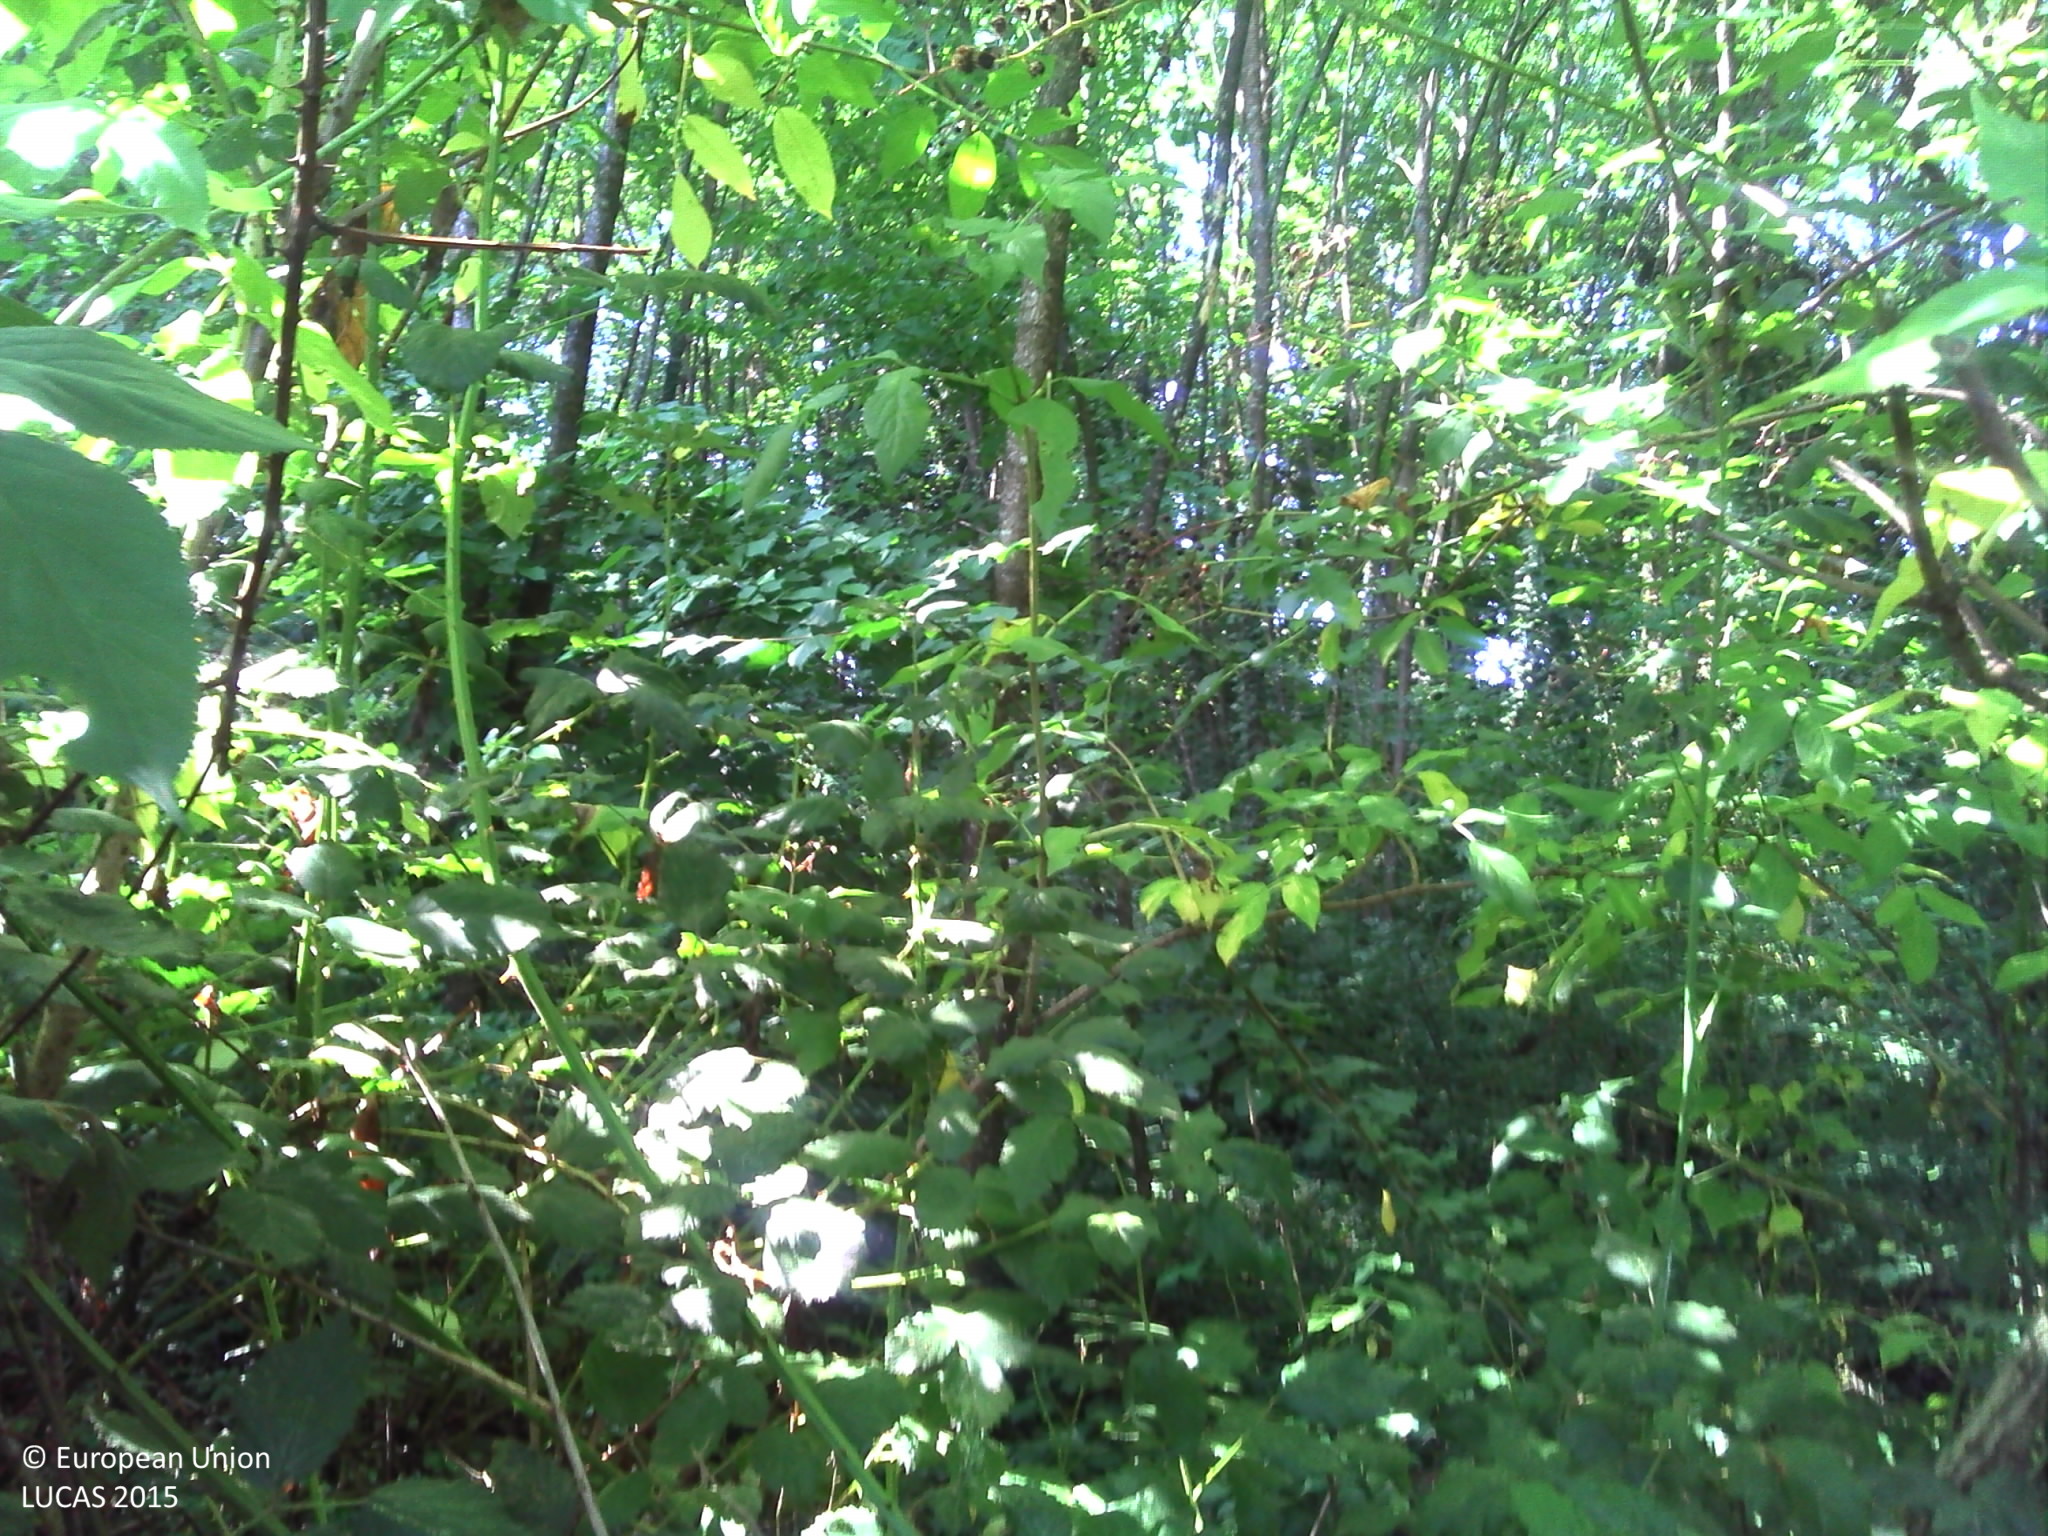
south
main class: Woodland
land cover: Broadleaved woodland
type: thermophilous deciduous forest
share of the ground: > 75 %
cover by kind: broadleaved forest trees 65 %, shrubs 20 %, herbaceous plants 10 %, lichens and mosses 5 %
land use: Forestry
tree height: > 5 m
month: August
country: FR
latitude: 43.4771
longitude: -1.1289
